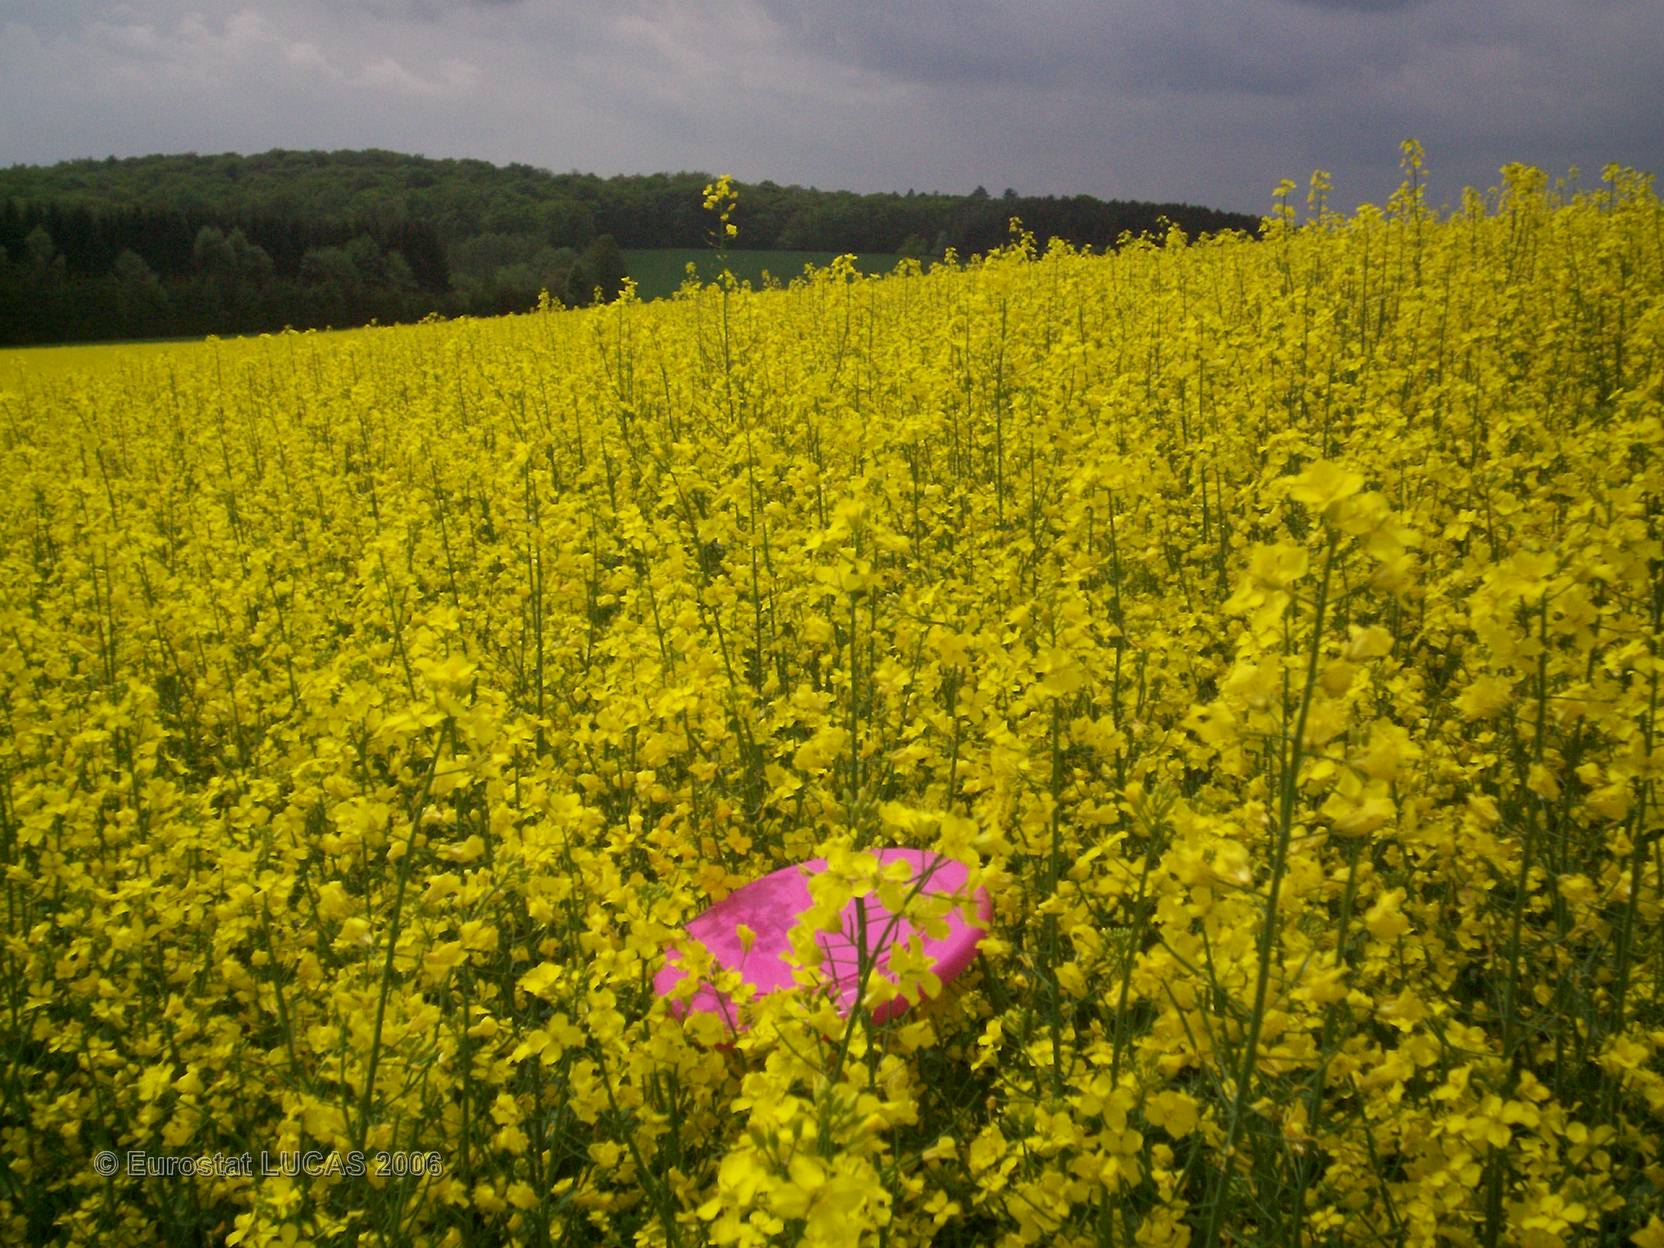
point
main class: Cropland
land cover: Rape and turnip rape
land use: Agriculture (excluding fallow land and kitchen gardens)
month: May
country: FR
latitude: 49.3895
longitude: 6.4040
